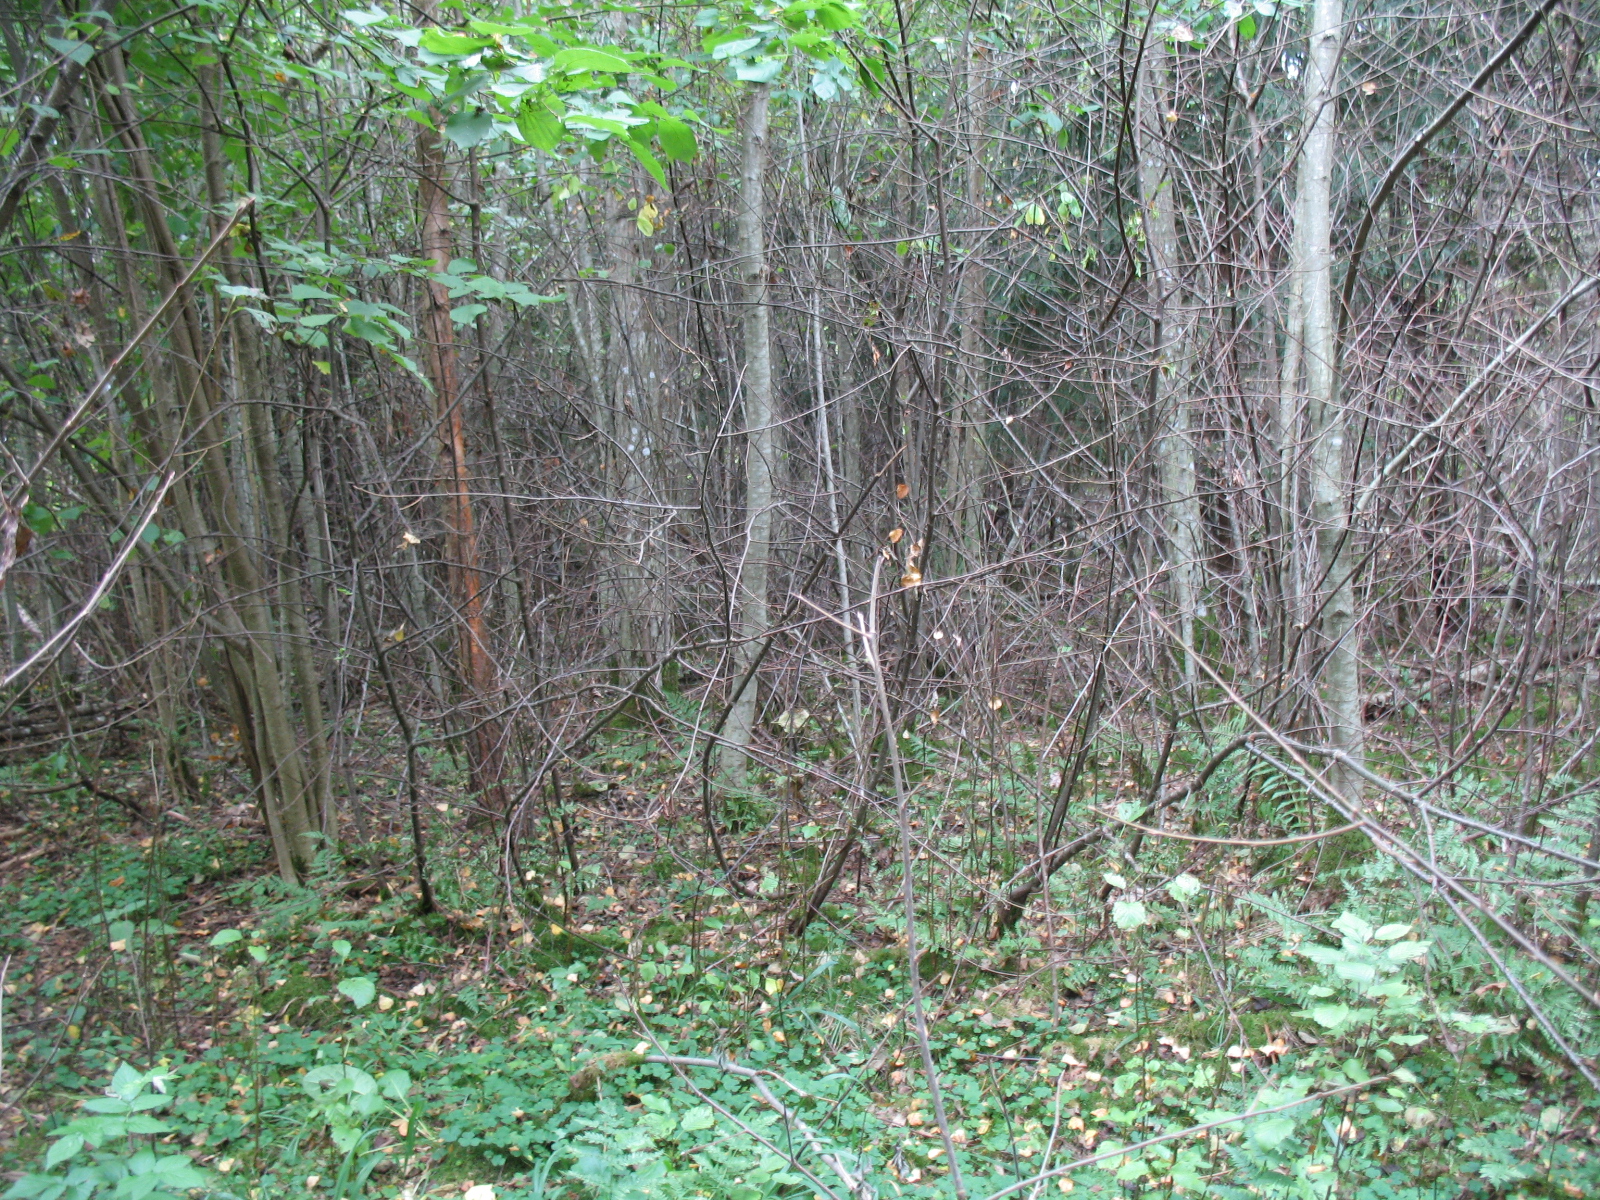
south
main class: Woodland
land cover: Broadleaved woodland
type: non-riverine alder, birch or aspen forest
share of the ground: > 75 %
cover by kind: broadleaved forest trees 80 %, coniferous forest trees 10 %, herbaceous plants 5 %, lichens and mosses 5 %
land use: Forestry
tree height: > 5 m
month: August
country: LV
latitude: 56.2779
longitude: 25.5465
